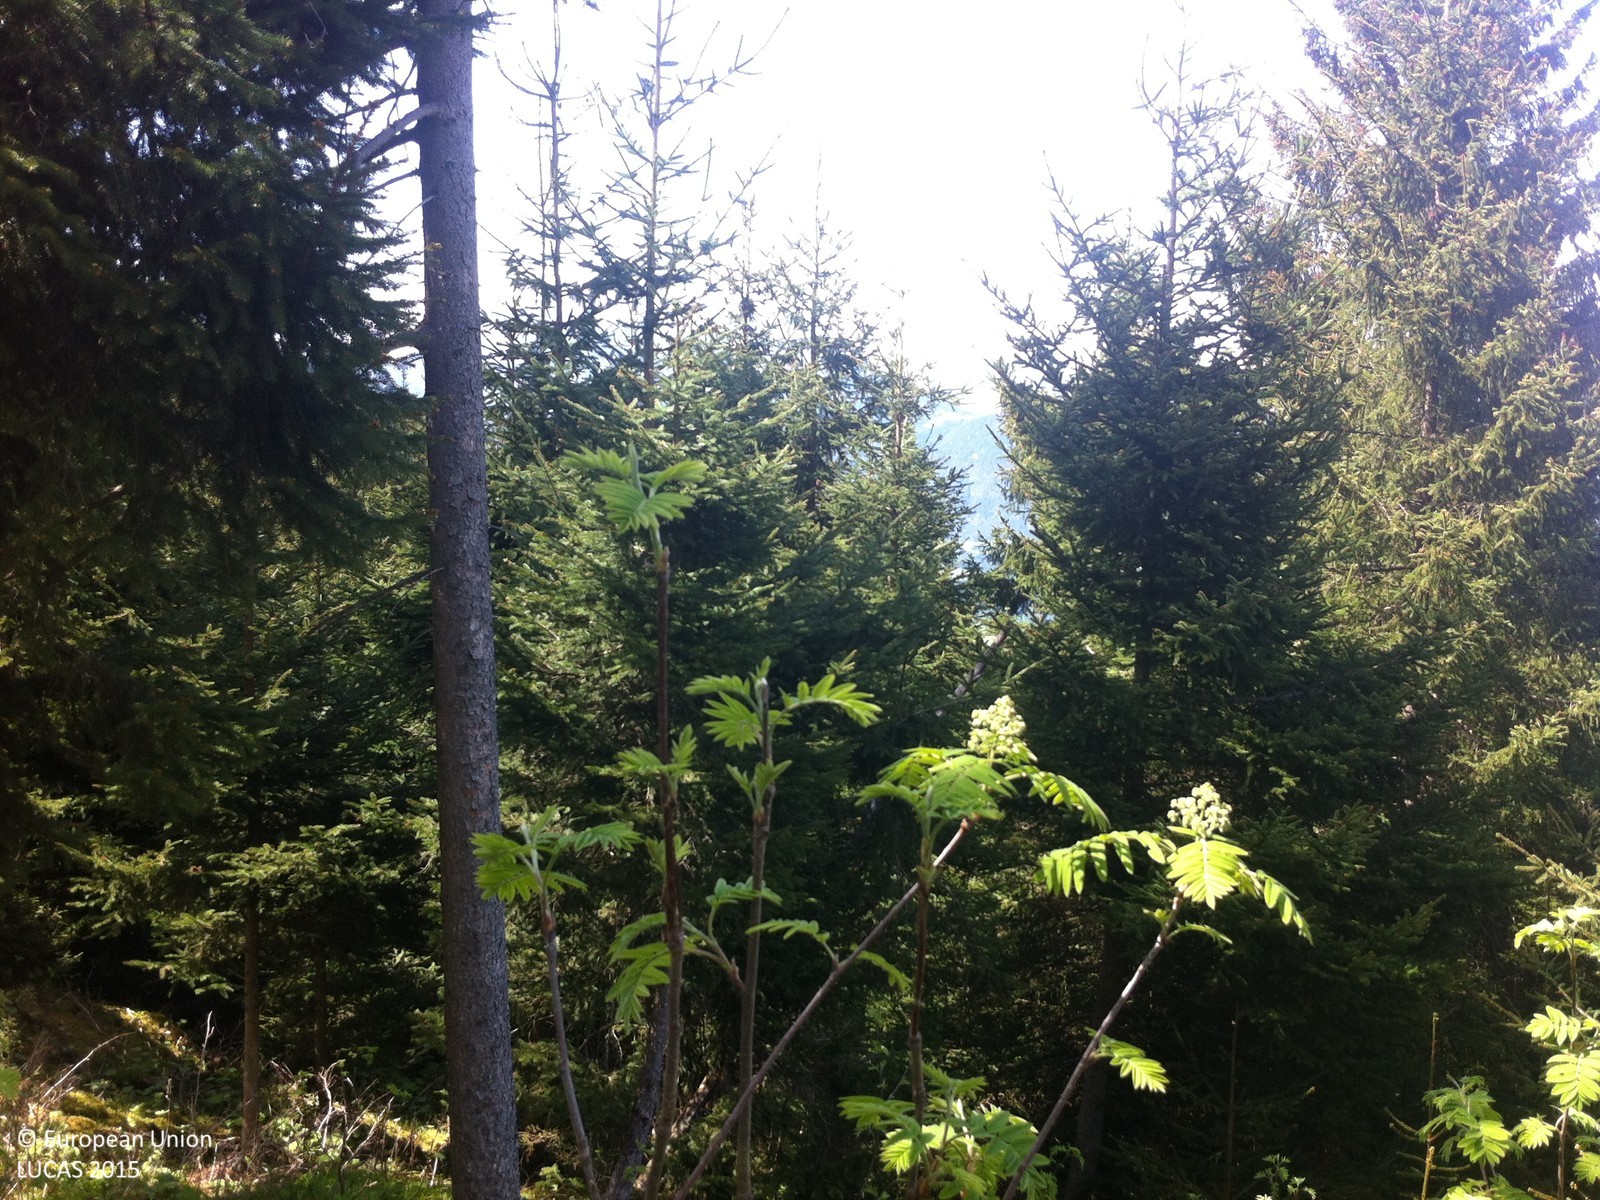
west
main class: Woodland
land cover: Other mixed woodland
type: alpine coniferous forest
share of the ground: > 75 %
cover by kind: coniferous forest trees 40 %, broadleaved forest trees 40 %, shrubs 20 %
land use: Forestry
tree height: < 5 m
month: May
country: AT
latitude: 47.2751
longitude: 11.6509
